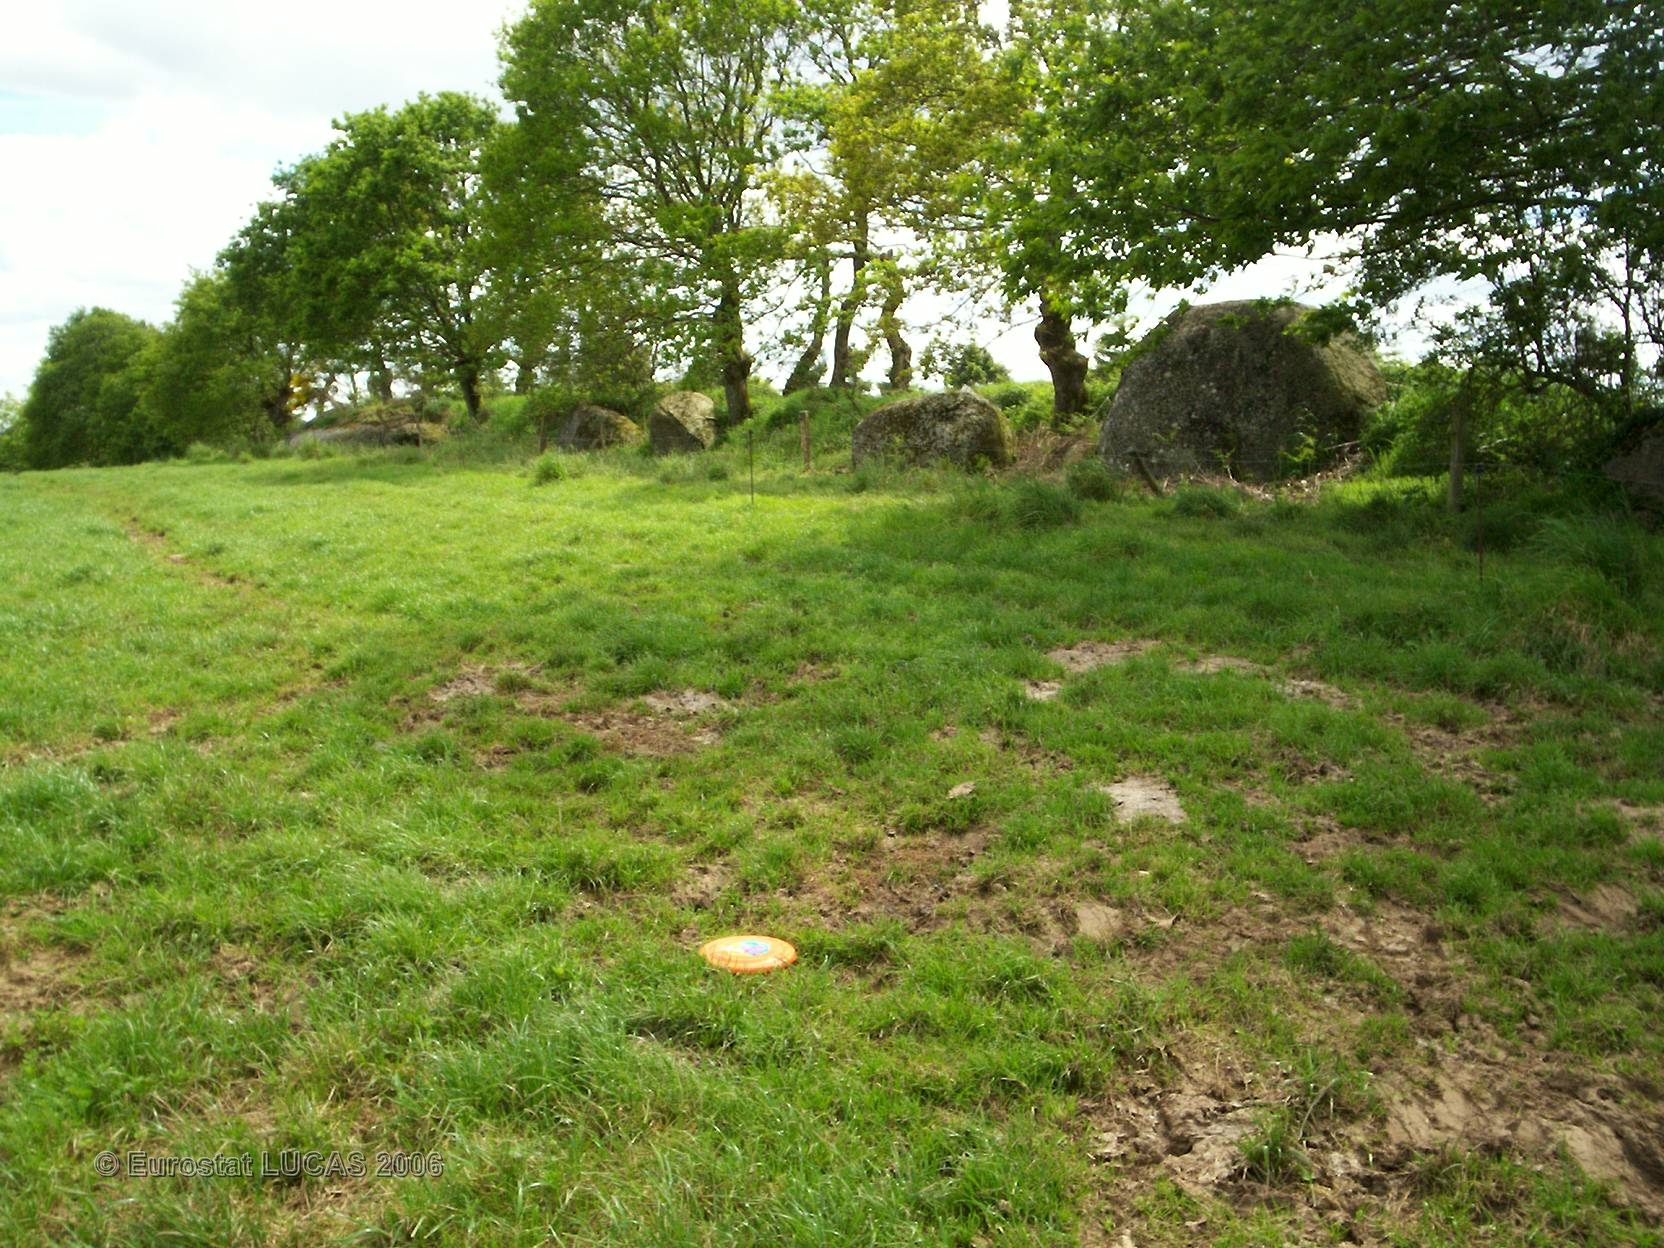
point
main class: Grassland
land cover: Grassland without tree/shrub cover
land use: Agriculture (excluding fallow land and kitchen gardens)
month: May
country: FR
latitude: 48.4011
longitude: -2.9687
